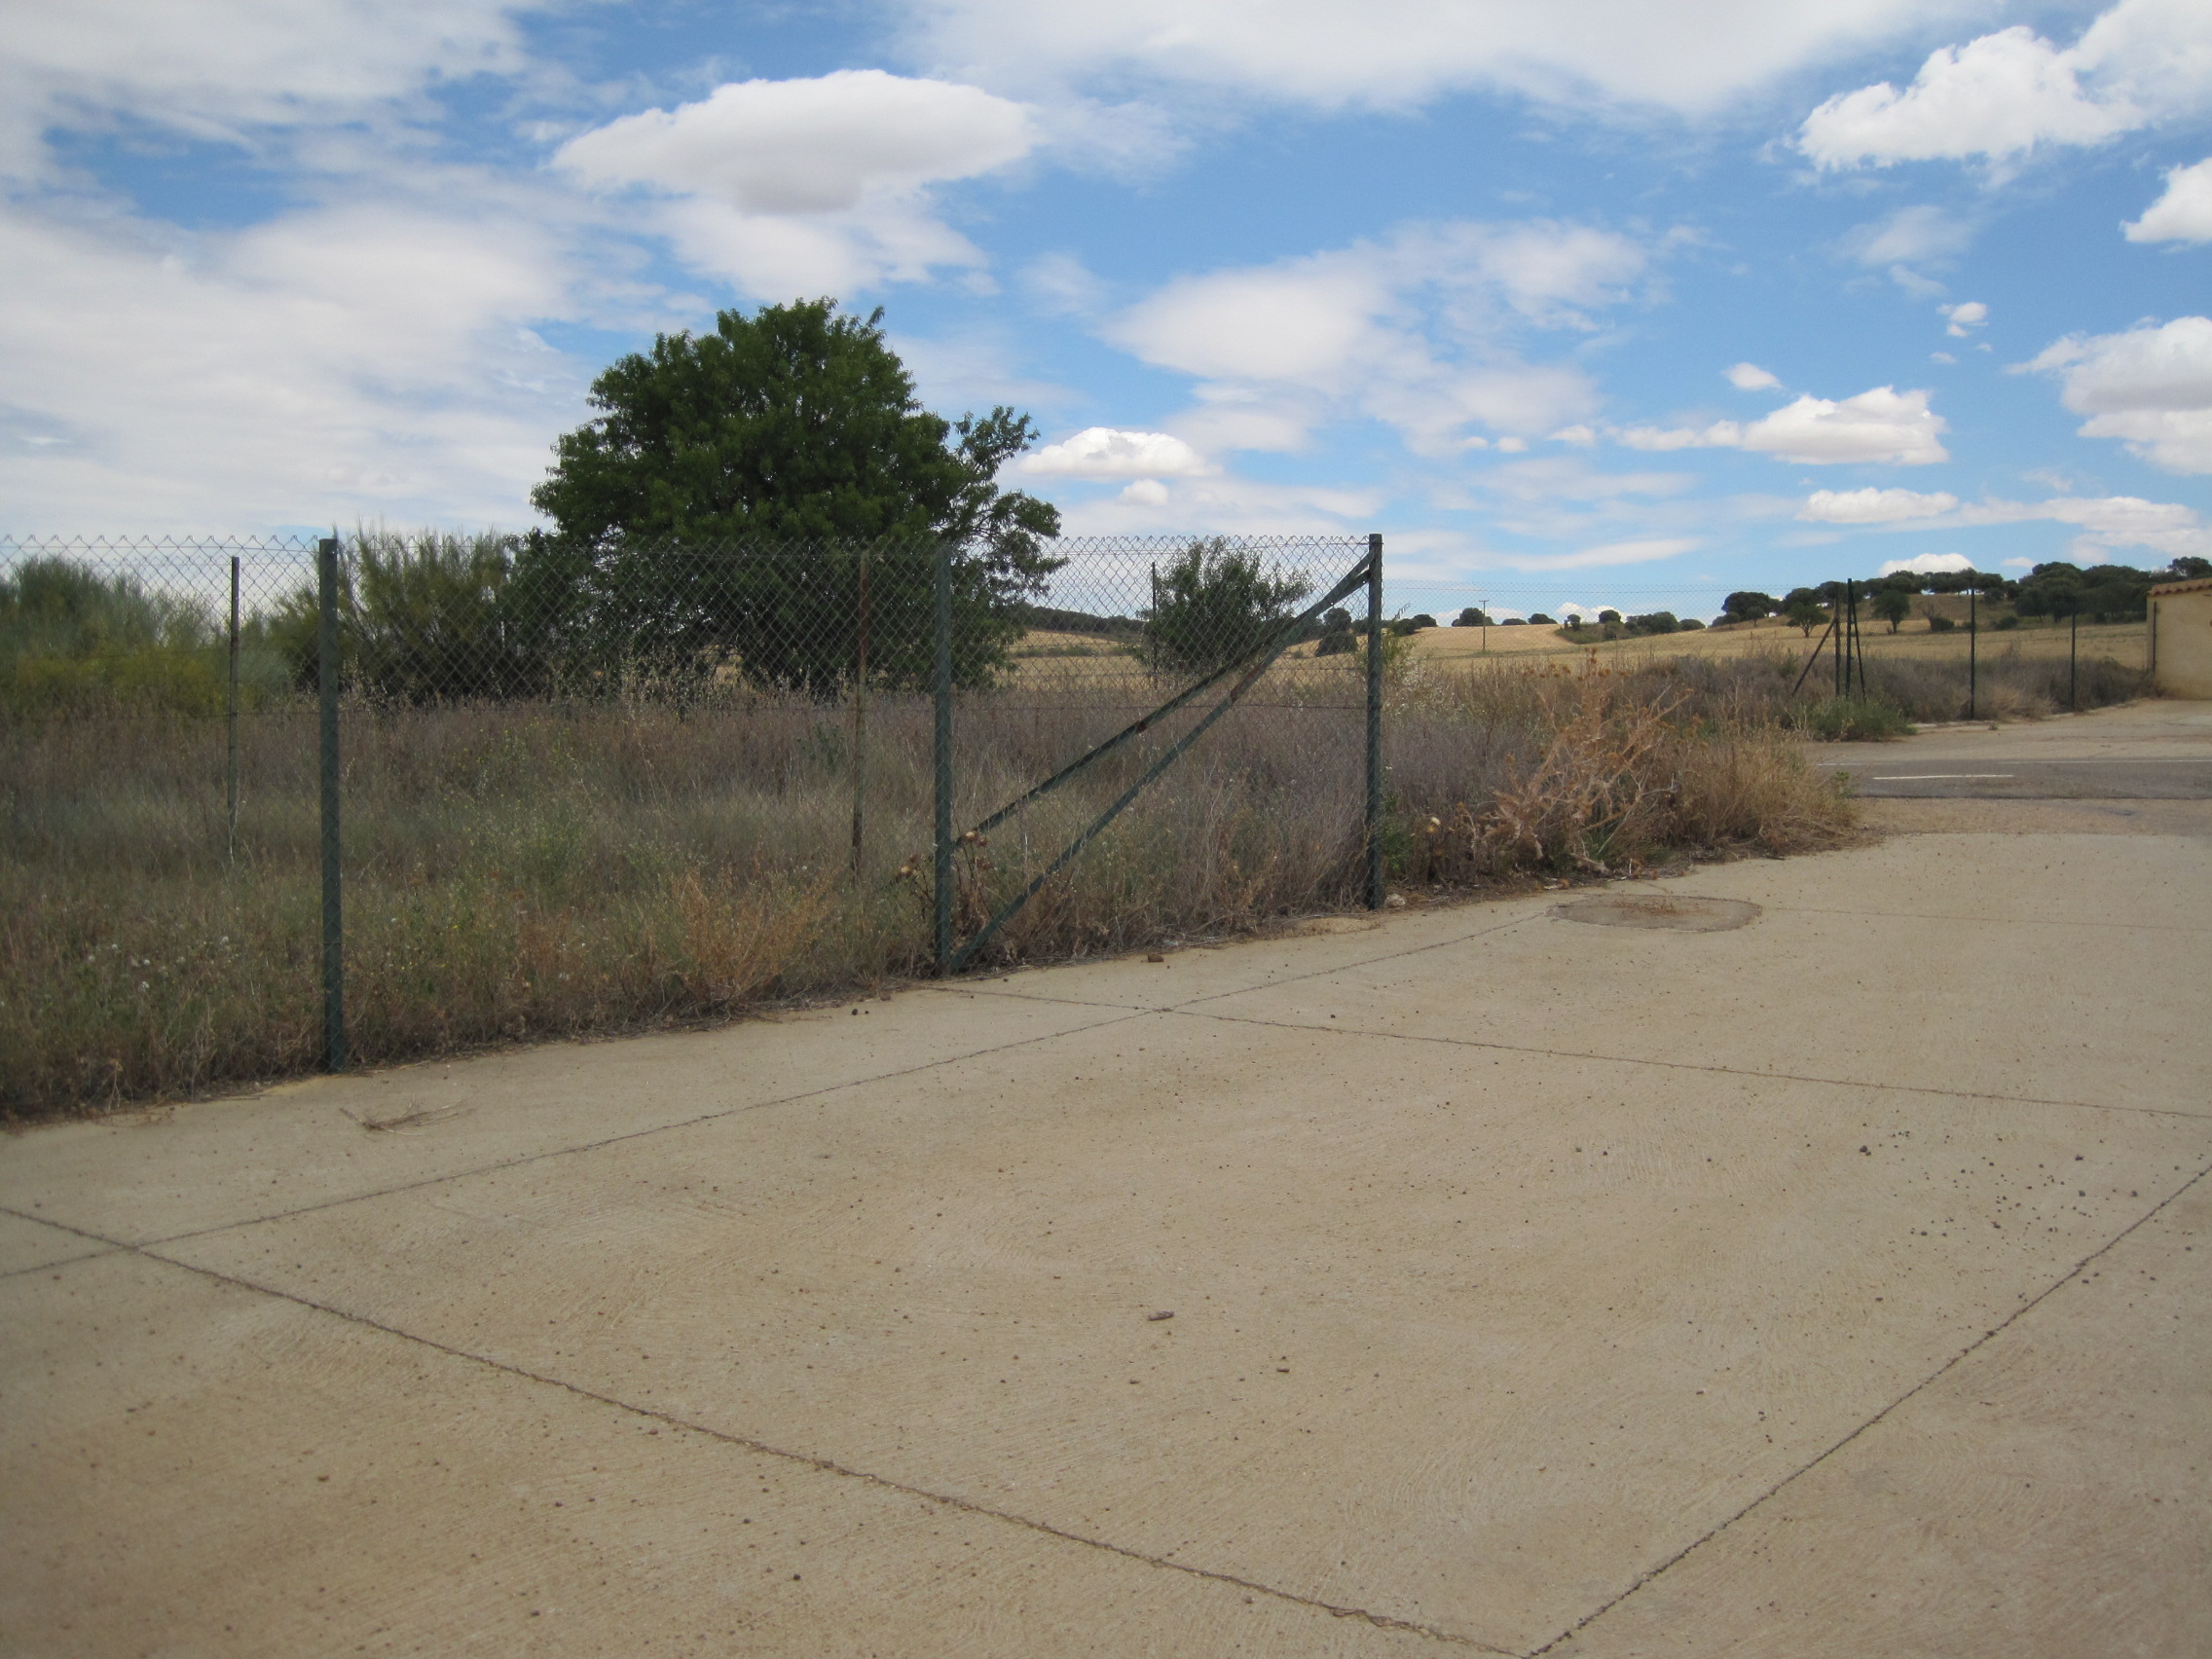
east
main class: Woodland
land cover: Broadleaved woodland
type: floodplain forest
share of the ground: > 75 %
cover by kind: broadleaved forest trees 80 %, herbaceous plants 20 %
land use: Forestry
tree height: > 5 m
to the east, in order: Broadleaved woodland; Grassland with sparse tree/shrub cover; Artificial constructions in urban areas; Grassland with sparse tree/shrub cover; Tracks; Grass margins; Arable land (only in case pi)
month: July
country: ES
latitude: 42.0830
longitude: -5.5761
